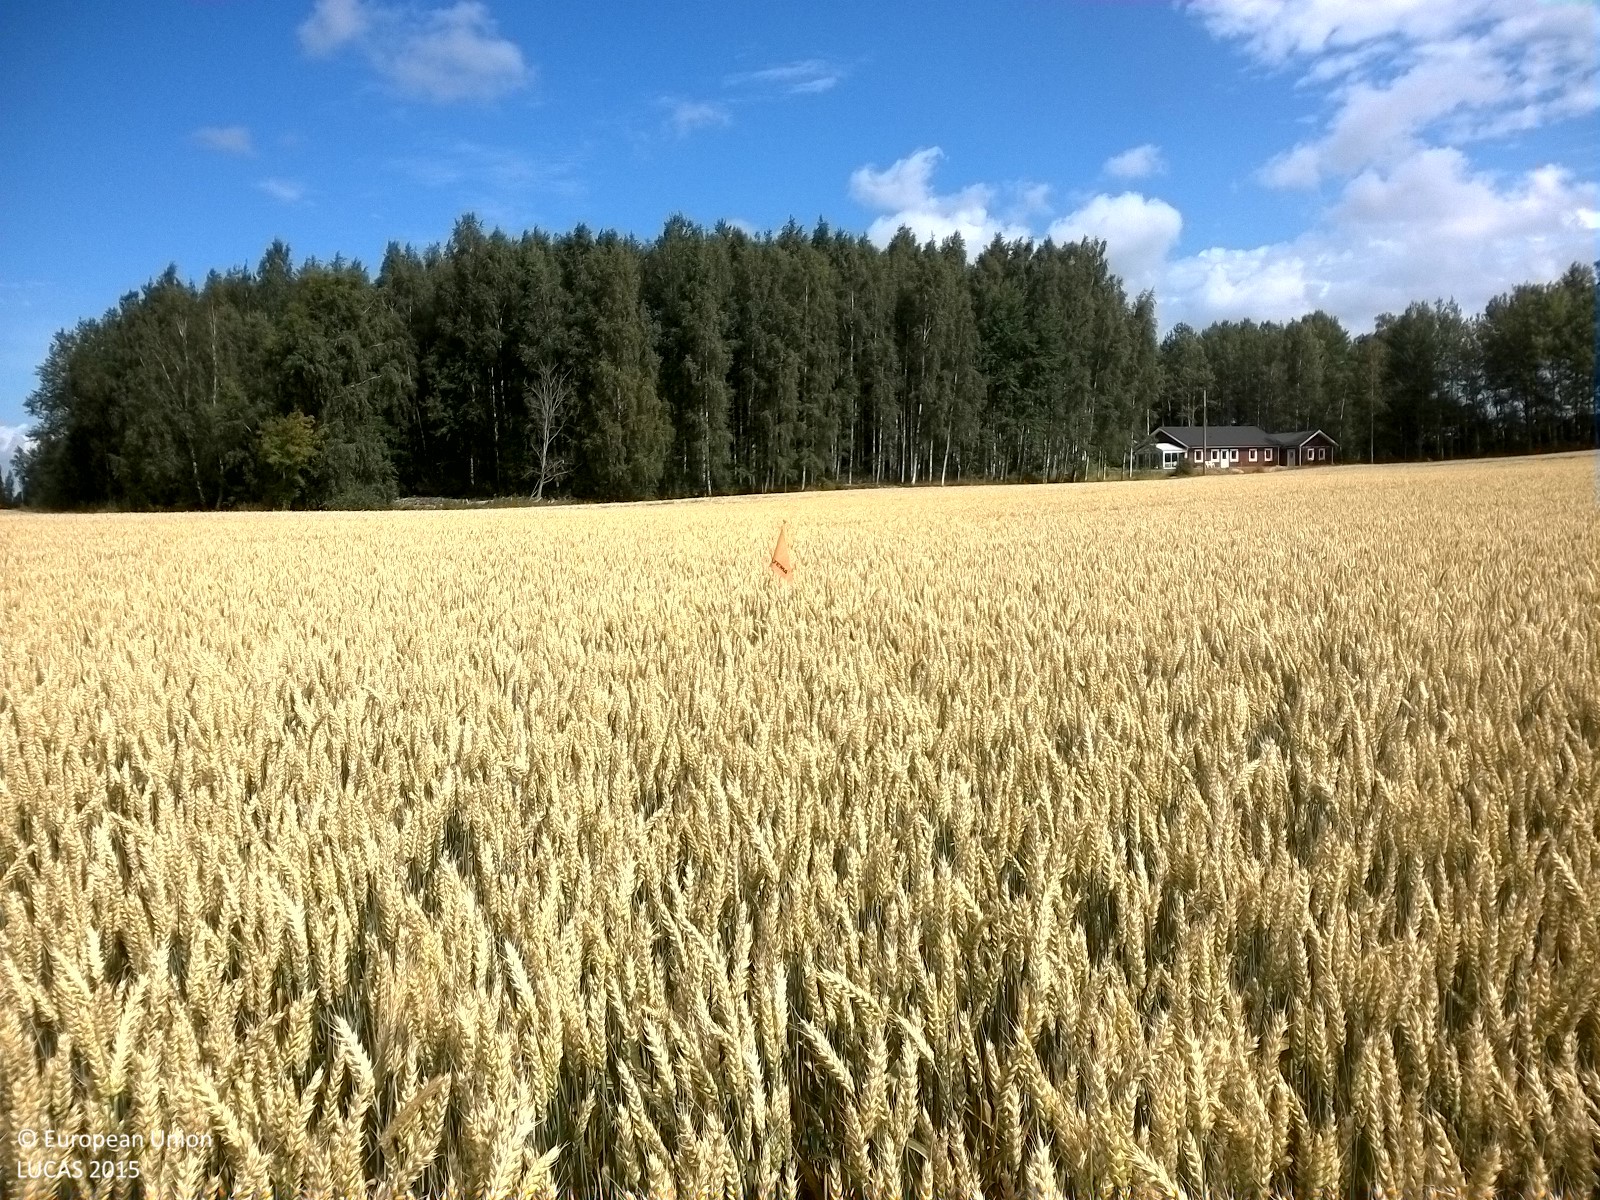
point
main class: Cropland
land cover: Common wheat
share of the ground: > 75 %
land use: Agriculture (excluding fallow land and kitchen gardens)
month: August
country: SE
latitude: 59.1692
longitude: 15.0824
